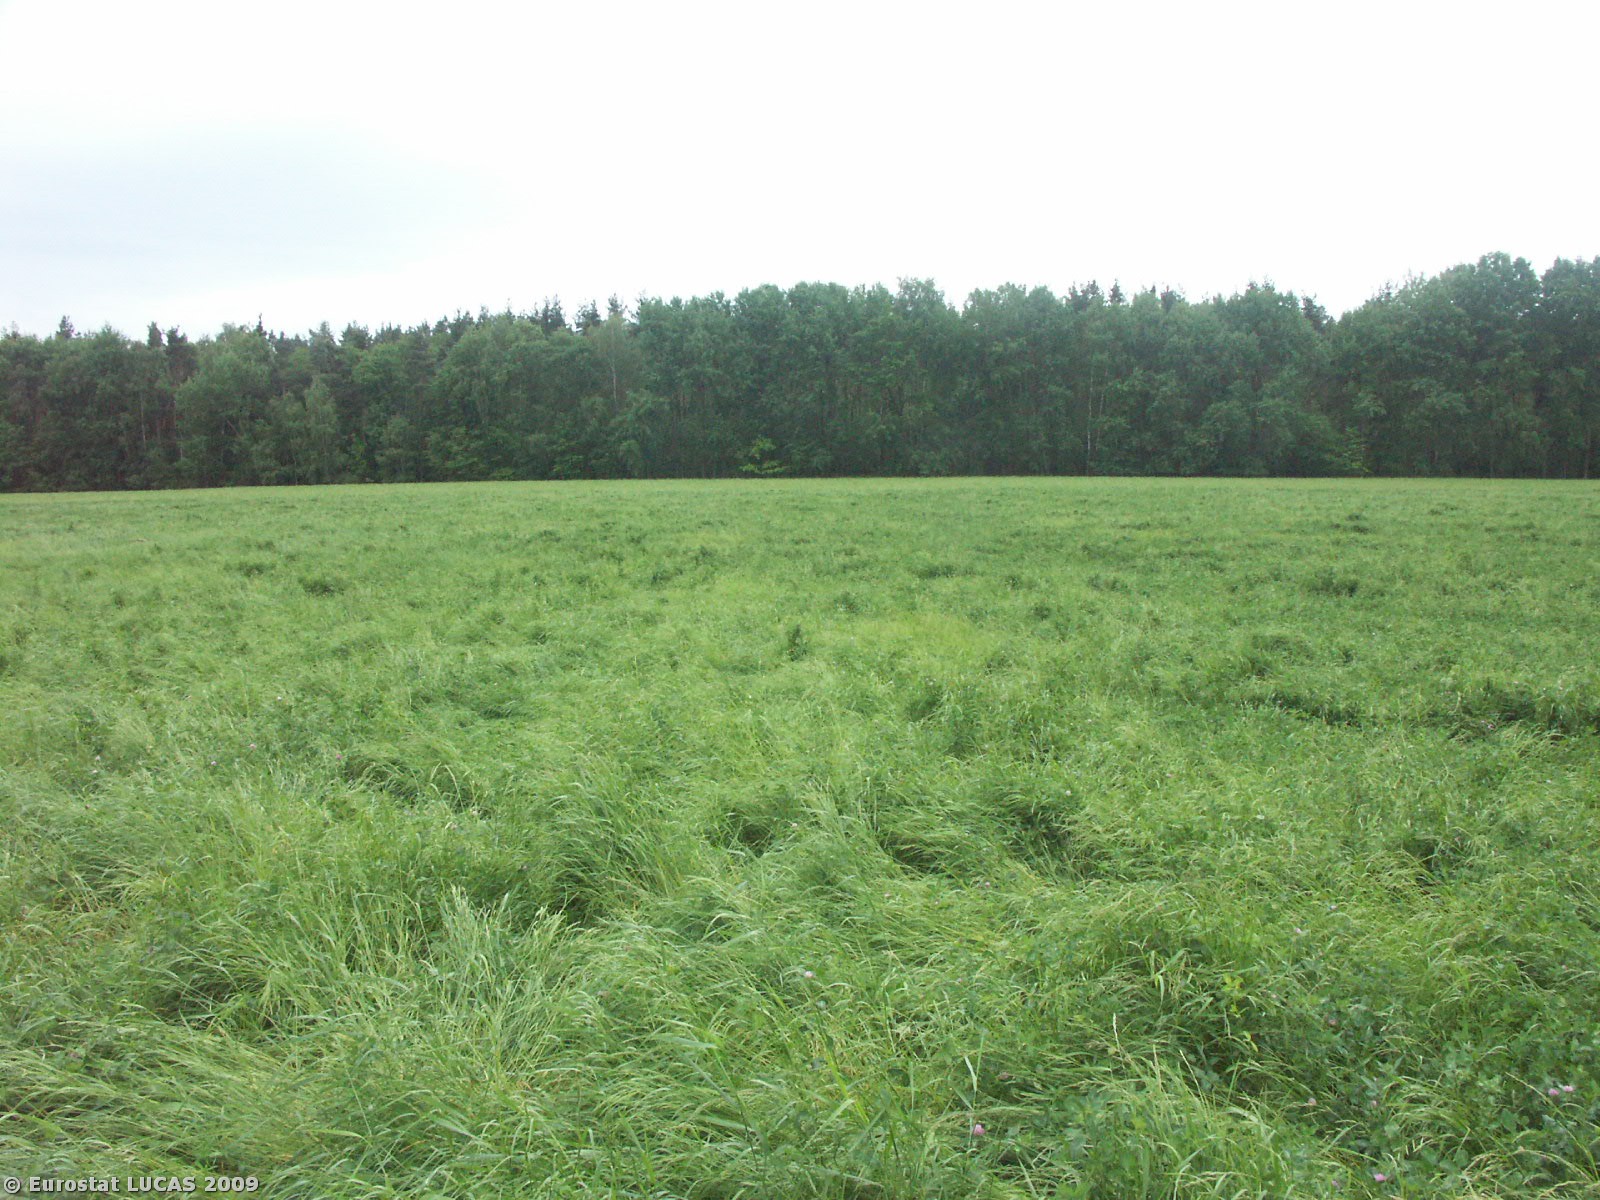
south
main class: Cropland
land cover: Temporary grasslands
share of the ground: 50 - 75 %
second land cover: Clovers
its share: 50 - 75 %
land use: Agriculture (excluding fallow land and kitchen gardens)
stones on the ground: < 10 %
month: May
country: CZ
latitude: 48.8912
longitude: 14.4337
